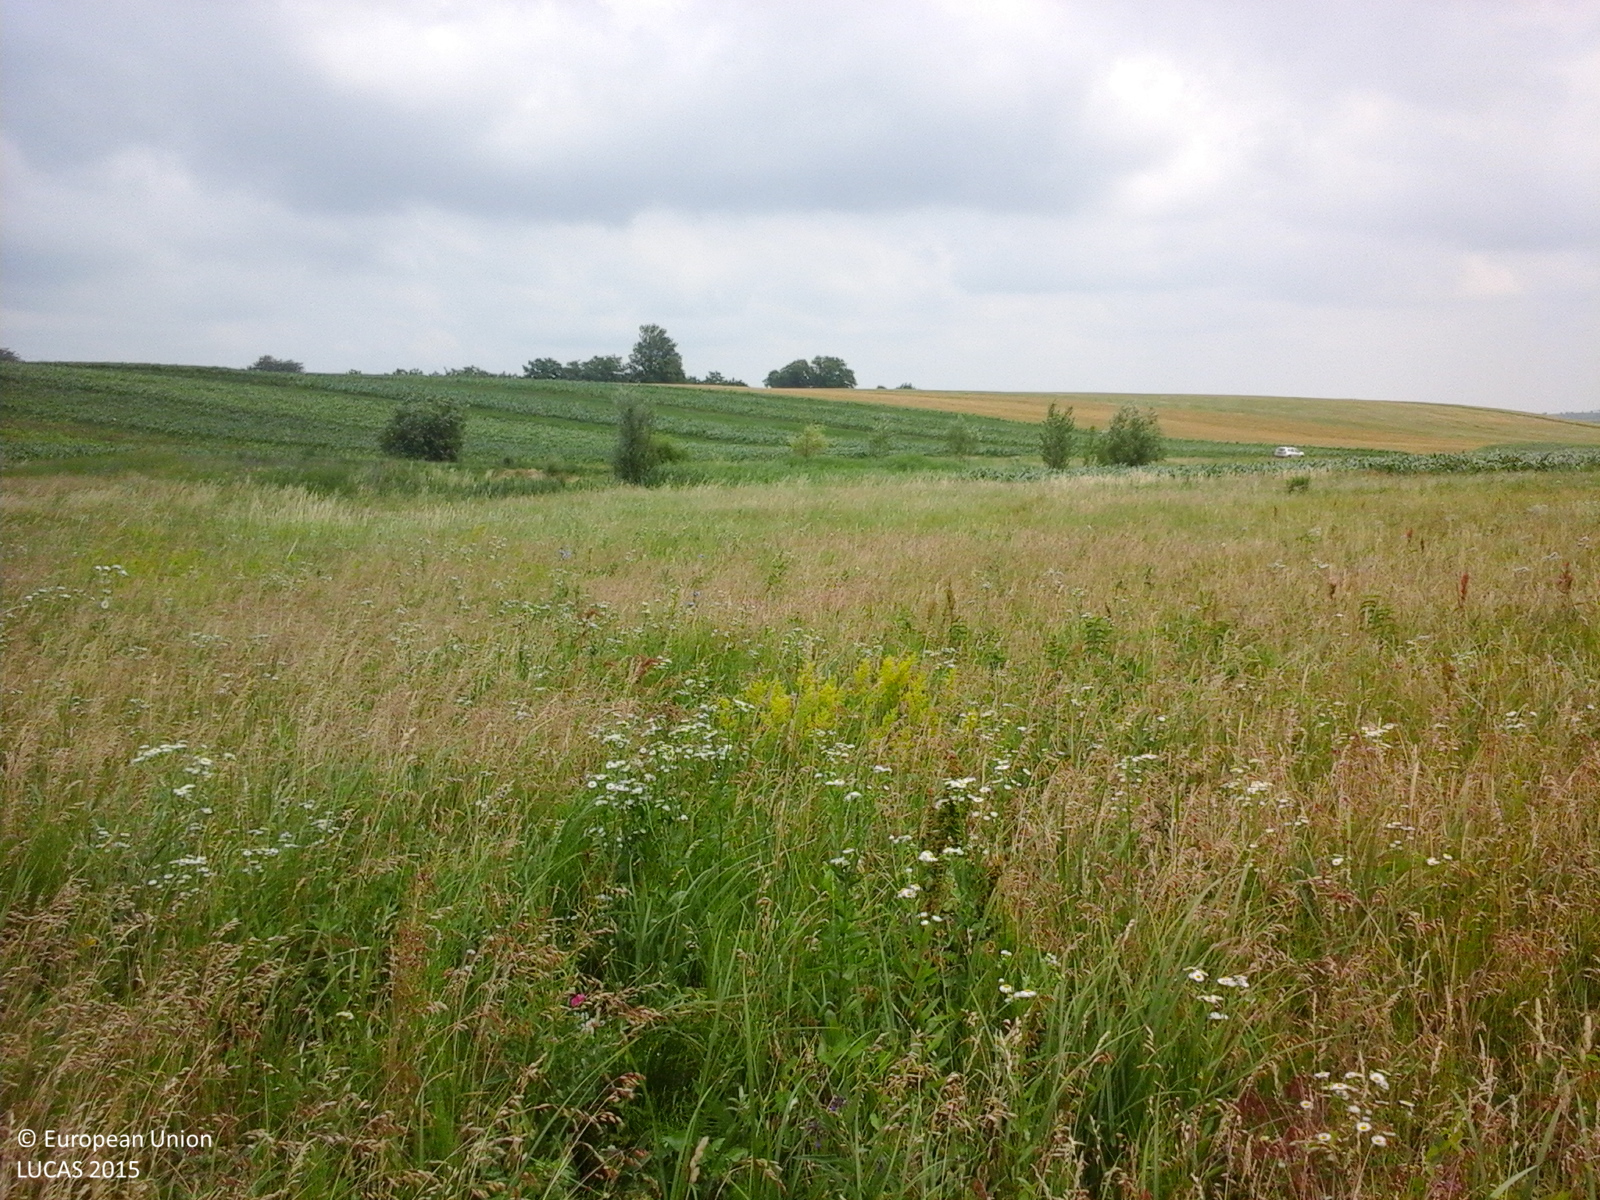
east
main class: Grassland
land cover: Grassland without tree/shrub cover
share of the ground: > 75 %
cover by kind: herbaceous plants 100 %
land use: Agriculture (excluding fallow land and kitchen gardens)
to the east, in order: Grassland without tree/shrub cover; Tracks; Grass margins; Inland marshes; Grassland without tree/shrub cover; Tracks; Grass margins; Maize; Lucerne; Maize; Lucerne; Tracks; Maize; Lucerne; Maize
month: June
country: RO
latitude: 48.0506
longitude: 26.3893
